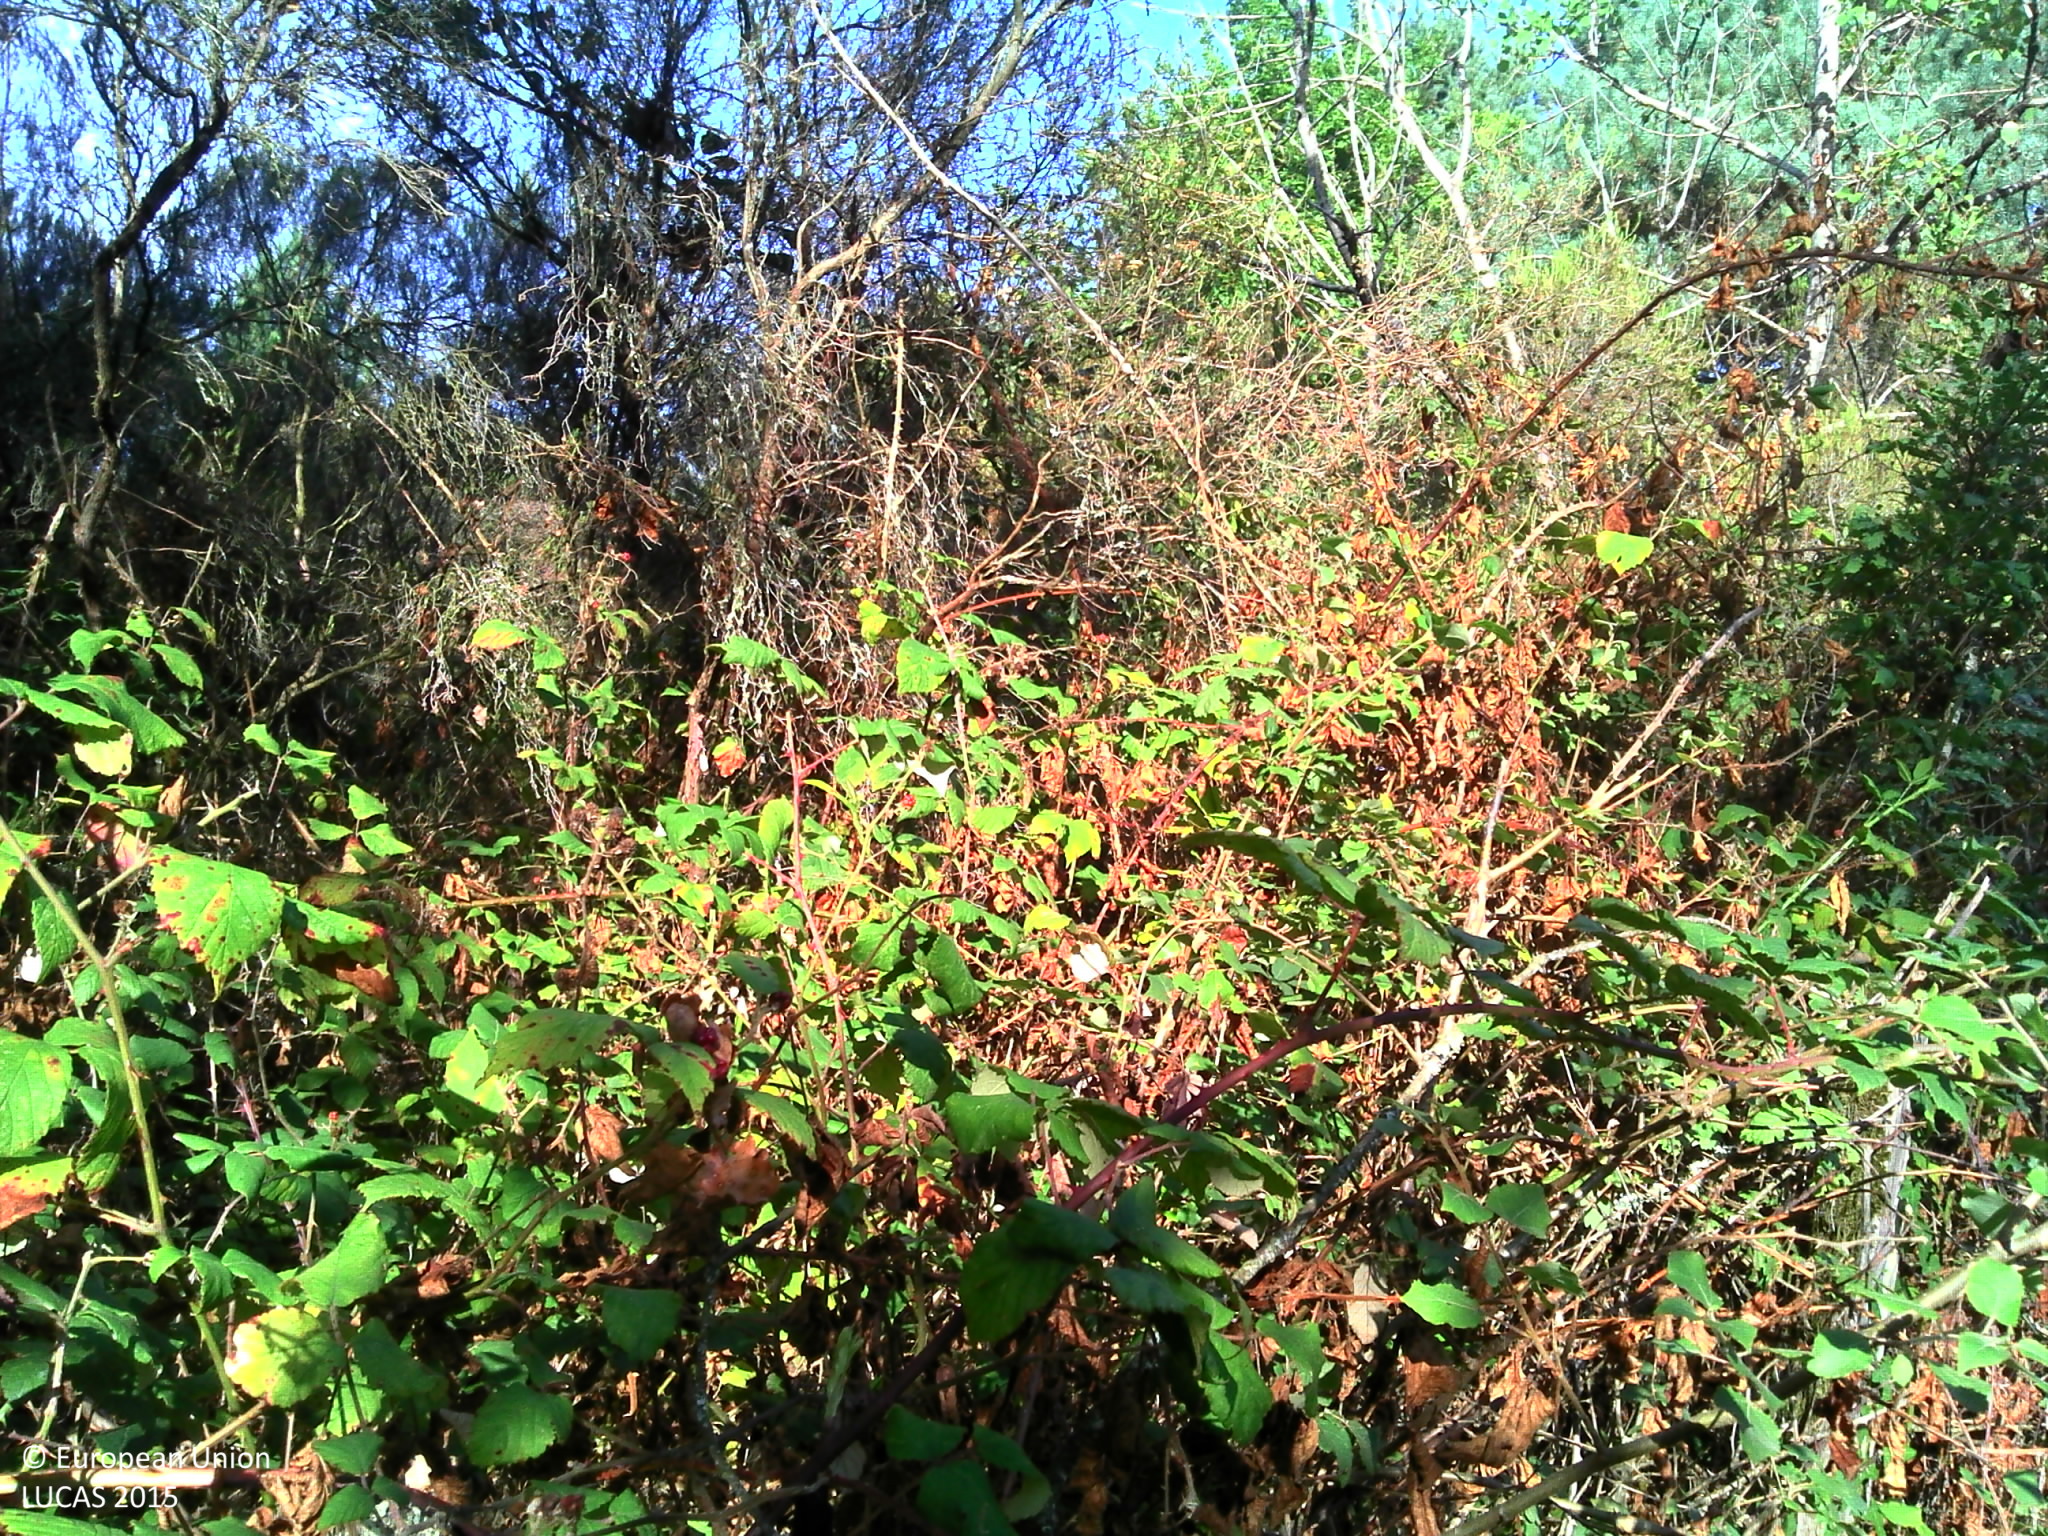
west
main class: Grassland
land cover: Spontaneously vegetated surfaces
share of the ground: > 75 %
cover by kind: herbaceous plants 60 %, unconsolidated bare surface 25 %, lichens and mosses 10 %, shrubs 5 %
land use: Semi-natural and natural areas not in use
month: August
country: FR
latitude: 45.4149
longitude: 0.6475
